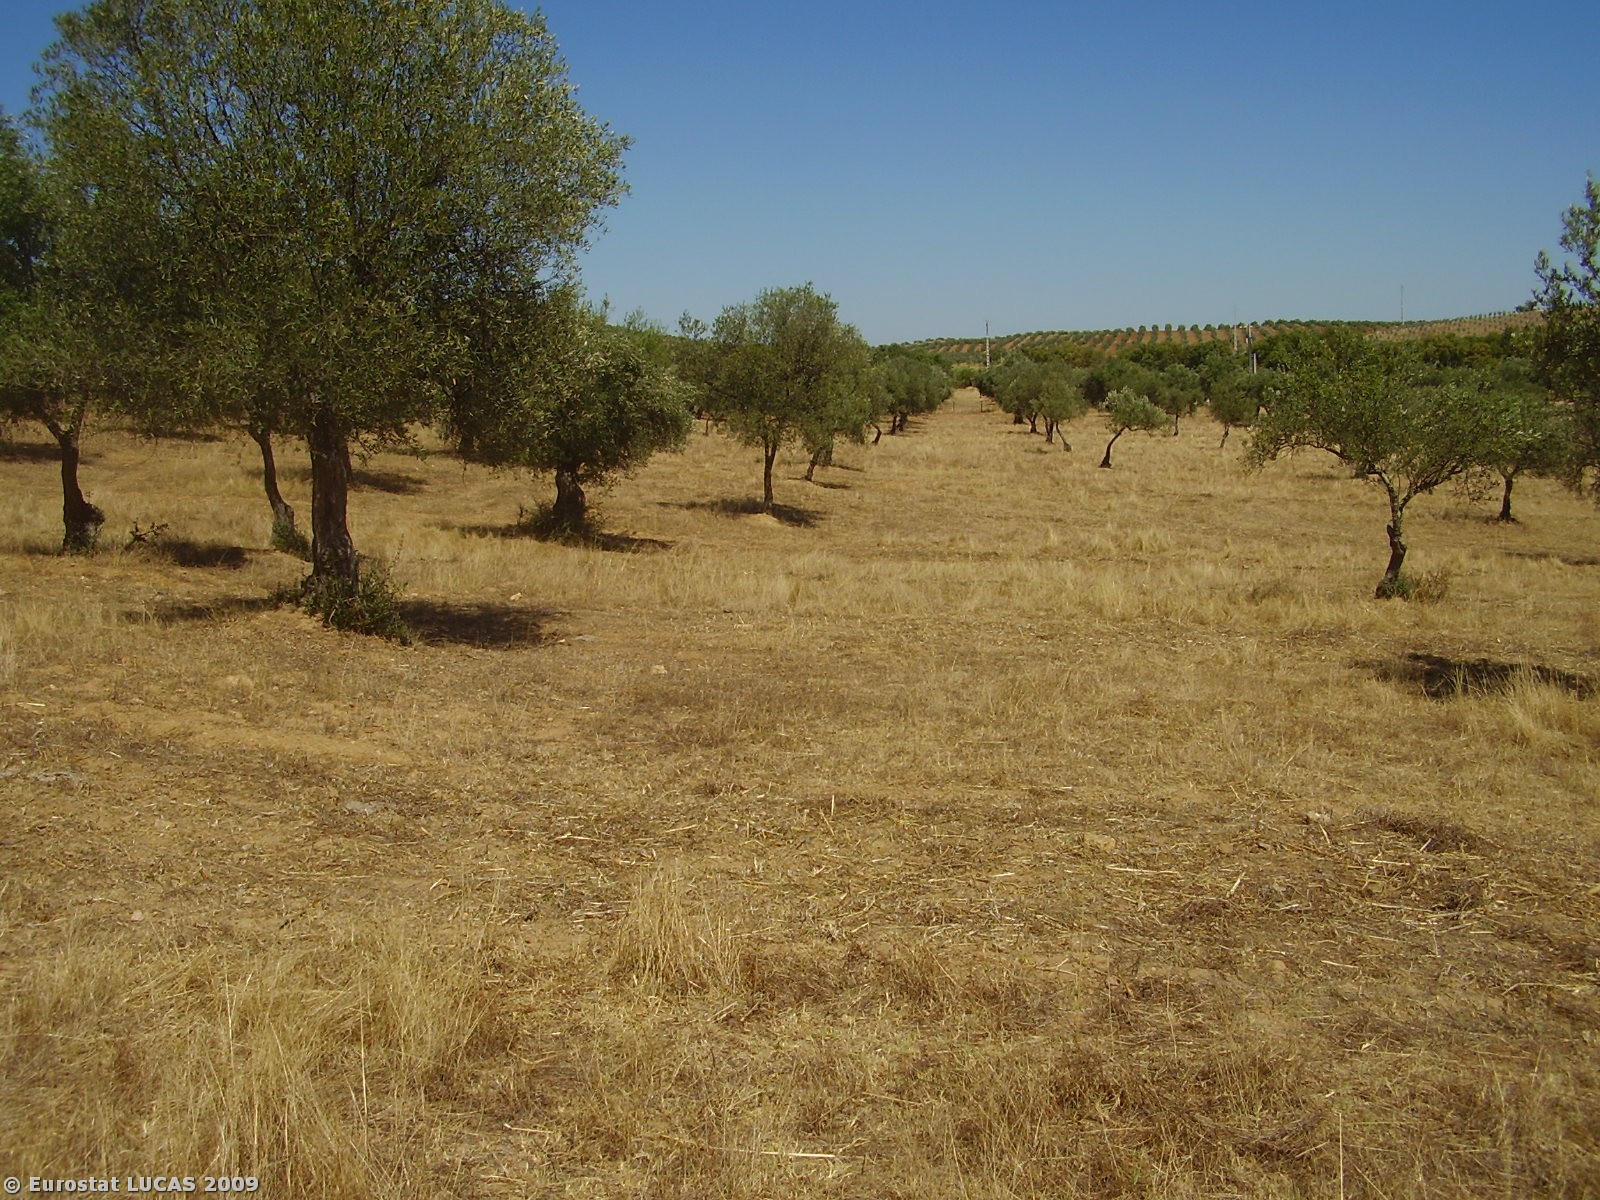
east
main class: Cropland
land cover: Olive groves
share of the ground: 25 - 50 %
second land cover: Spontaneously vegetated surfaces
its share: 25 - 50 %
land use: Agriculture (excluding fallow land and kitchen gardens)
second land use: Fallow land
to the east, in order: Olive groves; Spontaneously vegetated surfaces; Olive groves; Fences; Olive groves
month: July
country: PT
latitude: 37.8968
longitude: -7.5423
